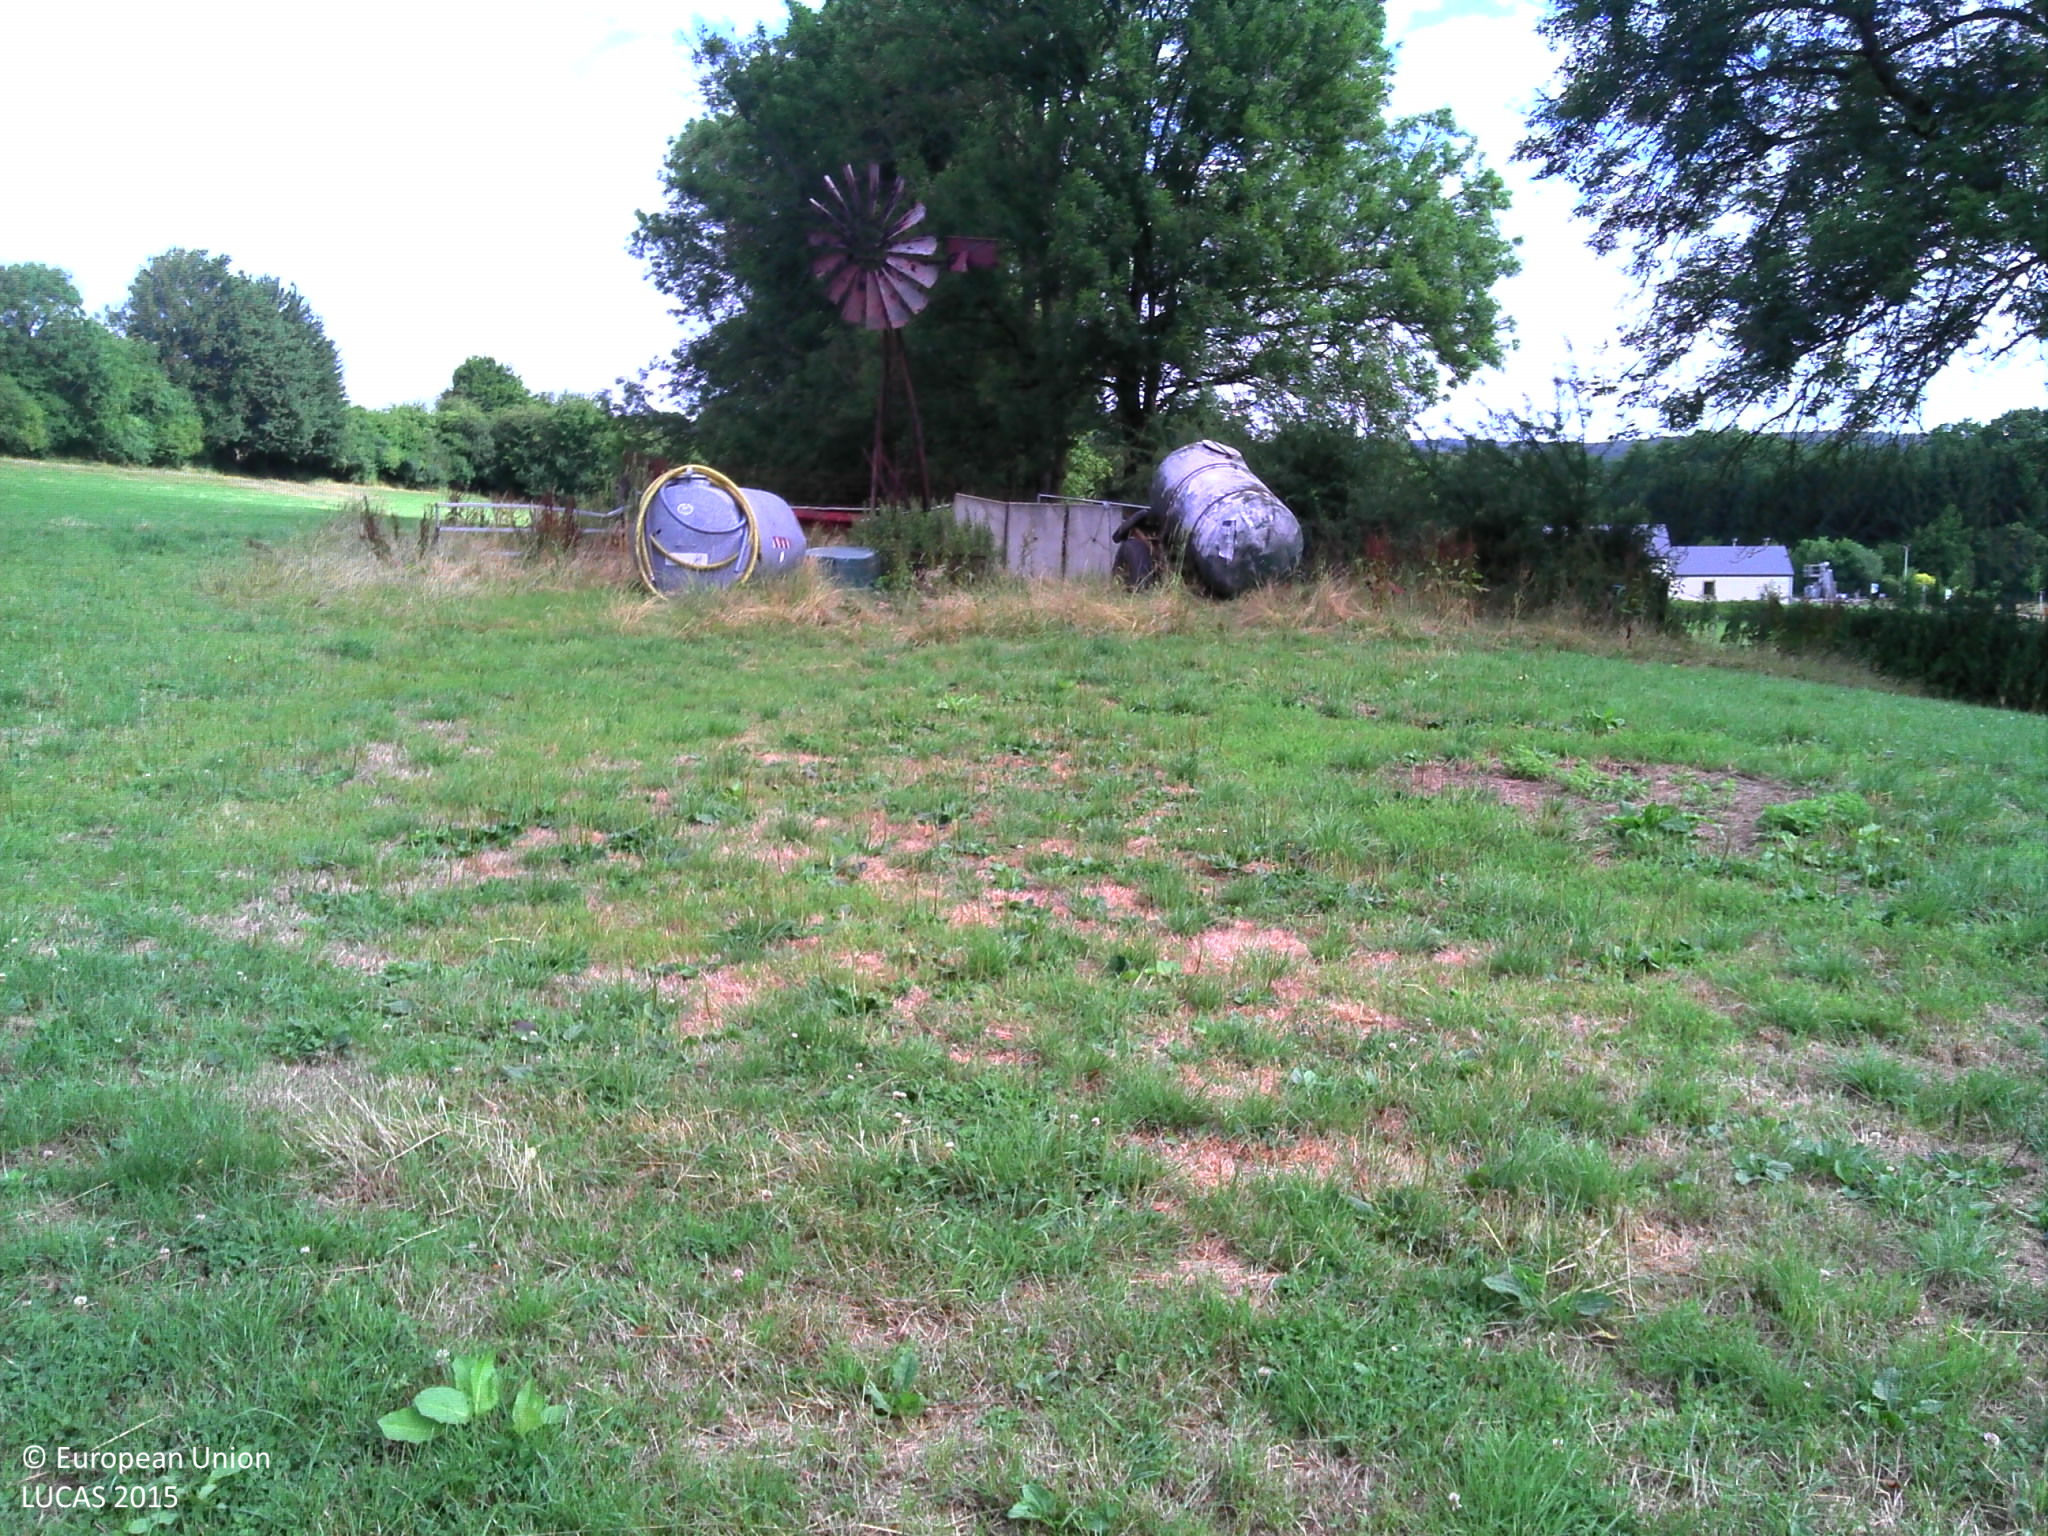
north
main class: Grassland
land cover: Grassland without tree/shrub cover
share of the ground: > 75 %
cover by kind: herbaceous plants 100 %
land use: Agriculture (excluding fallow land and kitchen gardens)
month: July
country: BE
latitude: 49.7090
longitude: 5.2970
